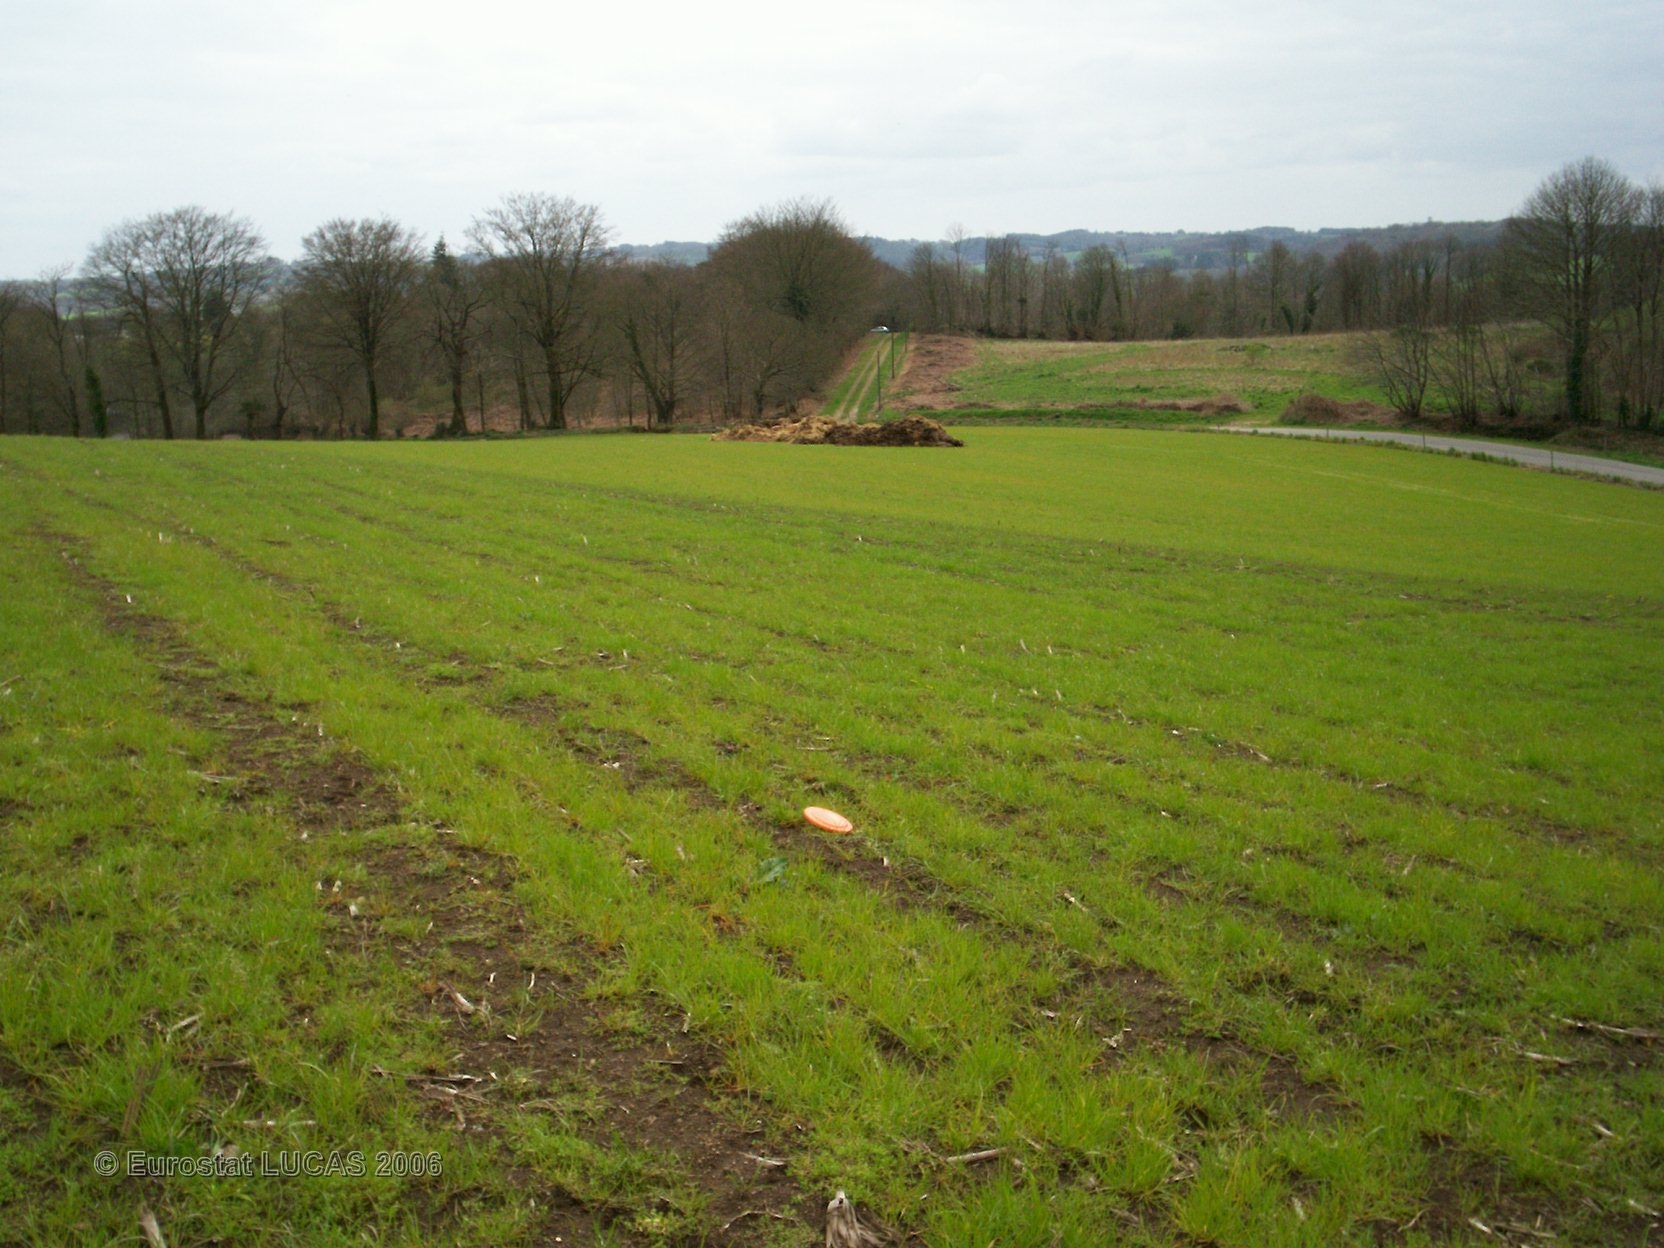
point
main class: Grassland
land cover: Grassland without tree/shrub cover
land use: Agriculture (excluding fallow land and kitchen gardens)
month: April
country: FR
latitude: 48.0027
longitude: -3.5478
